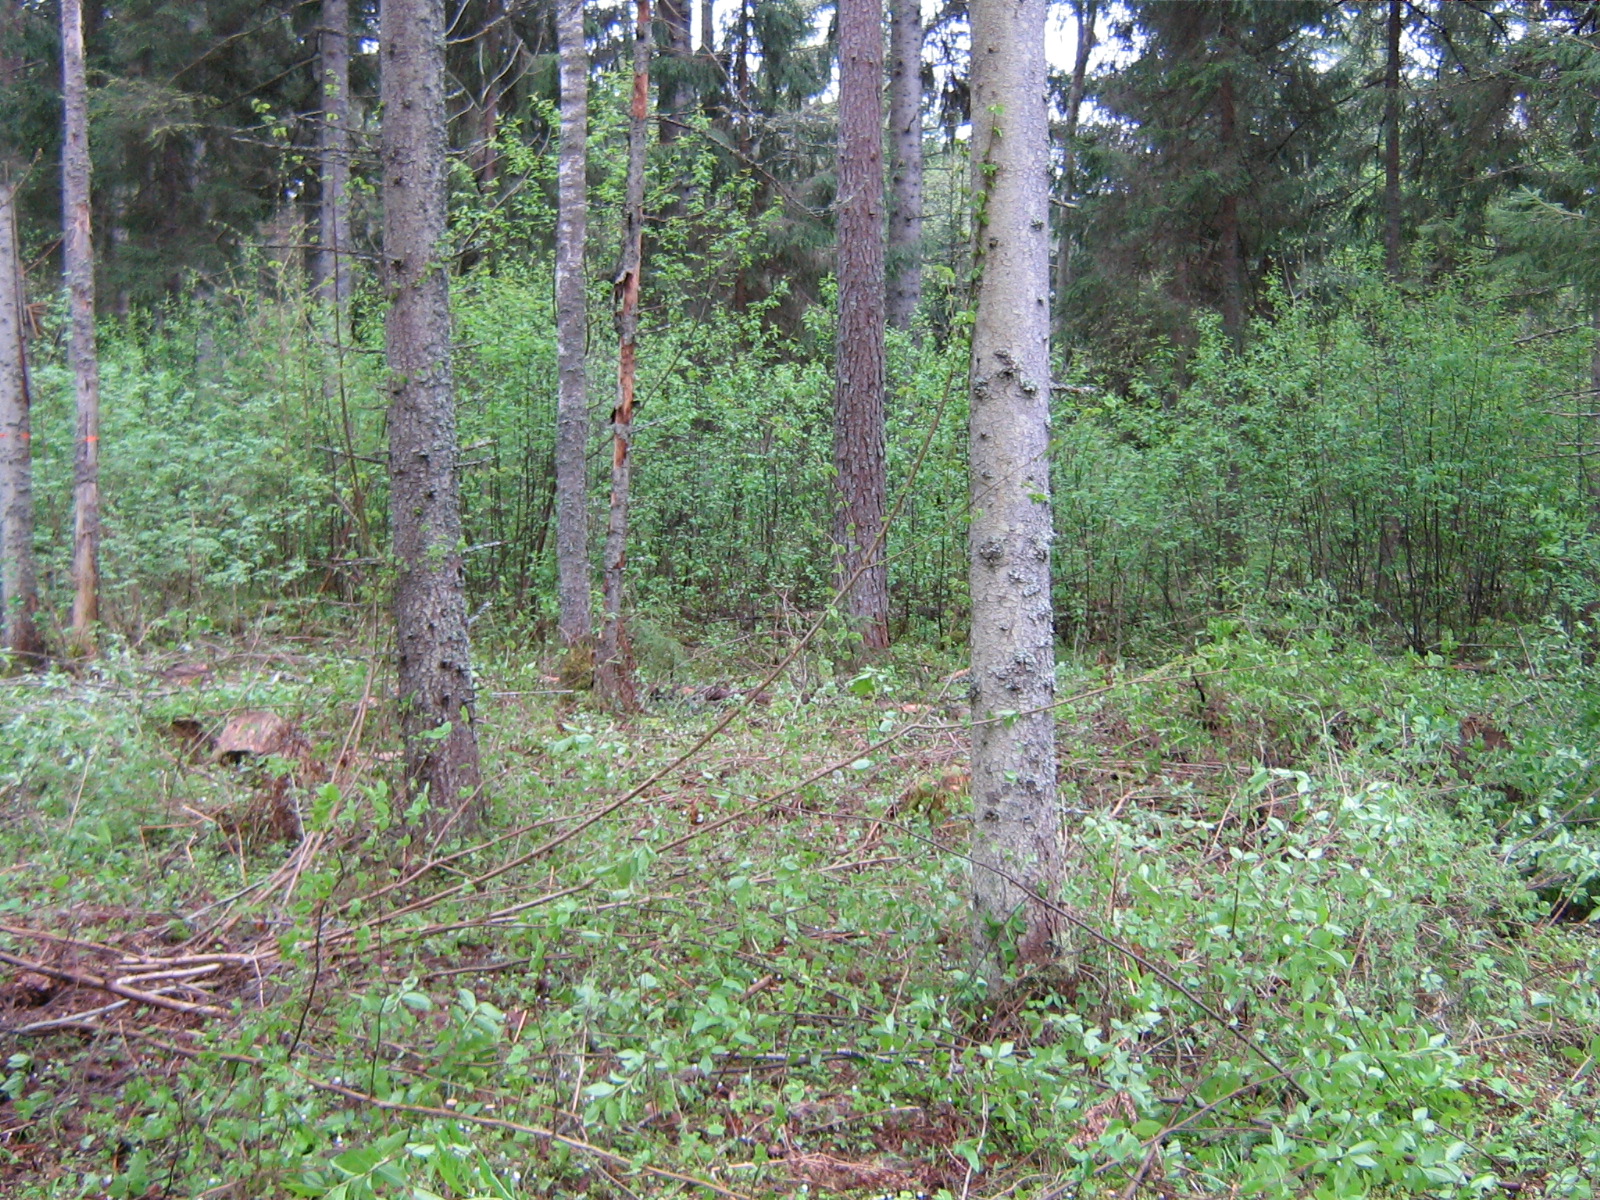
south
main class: Woodland
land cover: Spruce dominated mixed woodland
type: hemiboreal forest and nemoral coniferous forest and mixed broadleaved-coniferous forest
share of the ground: > 75 %
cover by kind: coniferous forest trees 60 %, broadleaved forest trees 25 %, shrubs 15 %
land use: Forestry
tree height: > 5 m
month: May
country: LV
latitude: 57.2042
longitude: 25.3249
